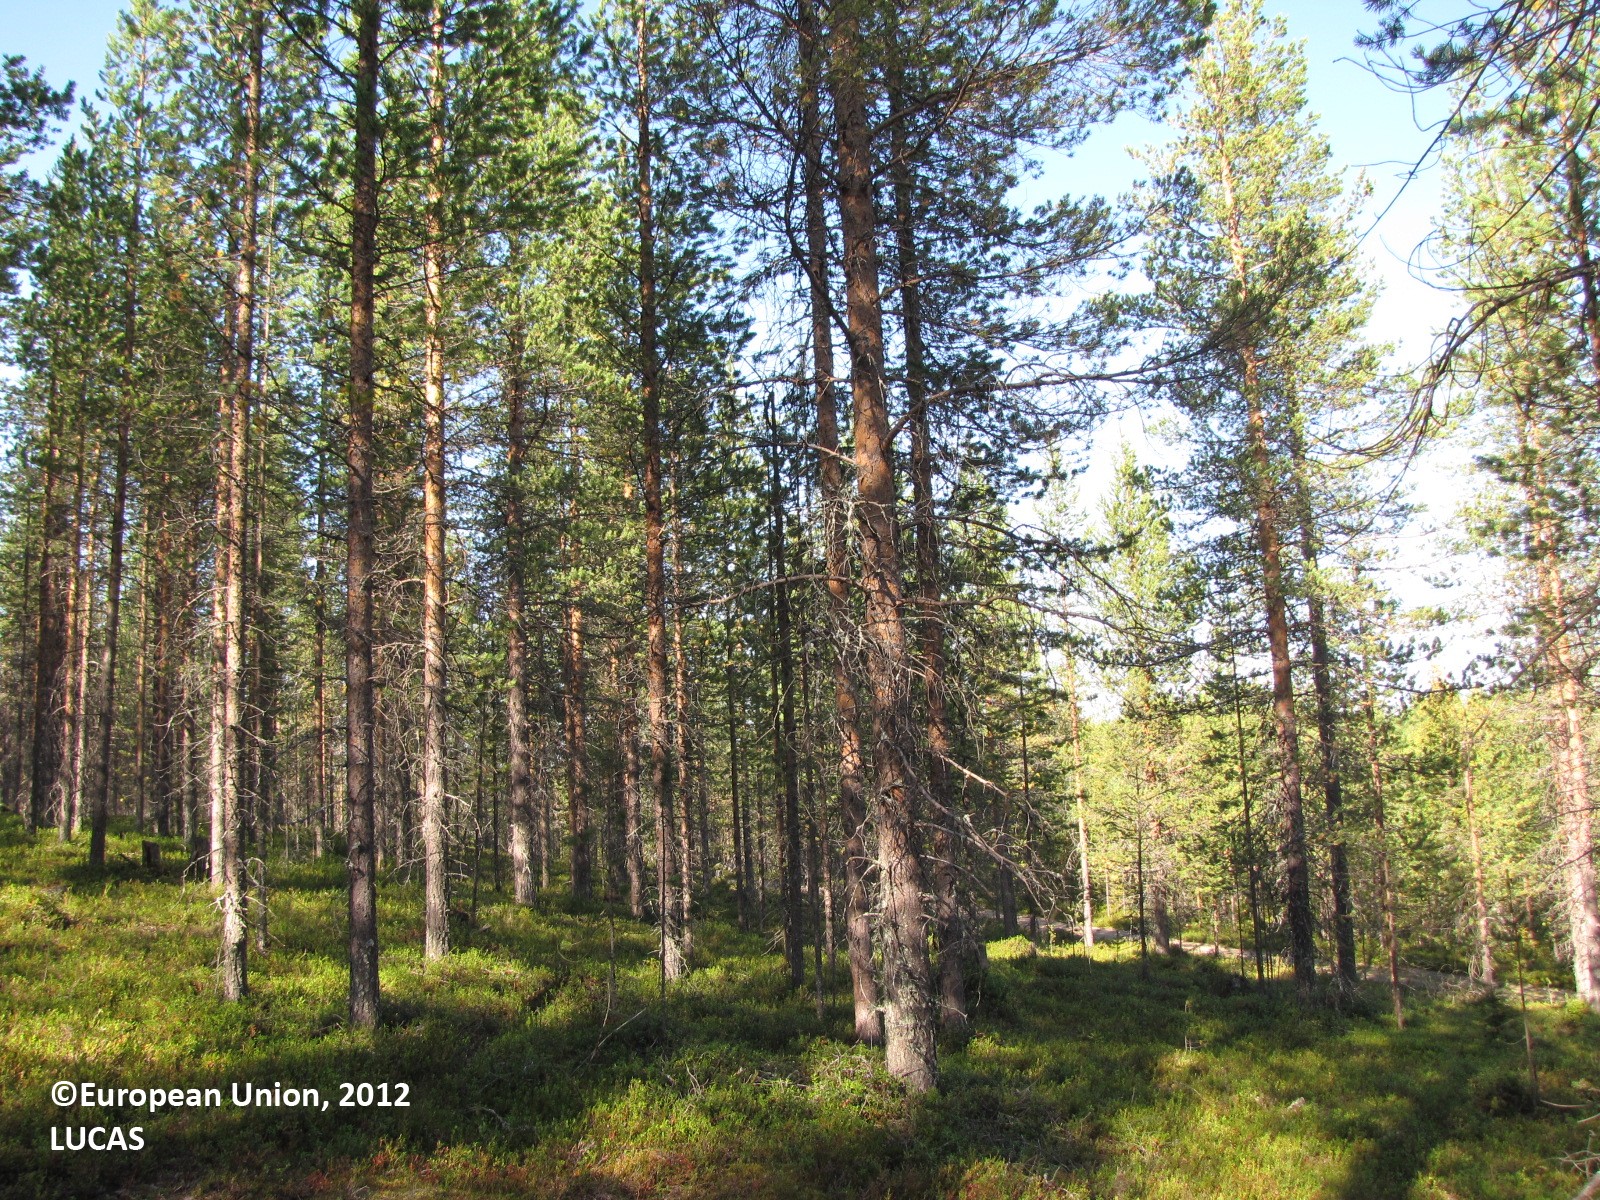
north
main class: Woodland
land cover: Pine dominated coniferous woodland
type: boreal forest
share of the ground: 25 - 50 %
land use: Forestry
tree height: > 5 m
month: August
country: FI
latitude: 67.0071
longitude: 25.2150
